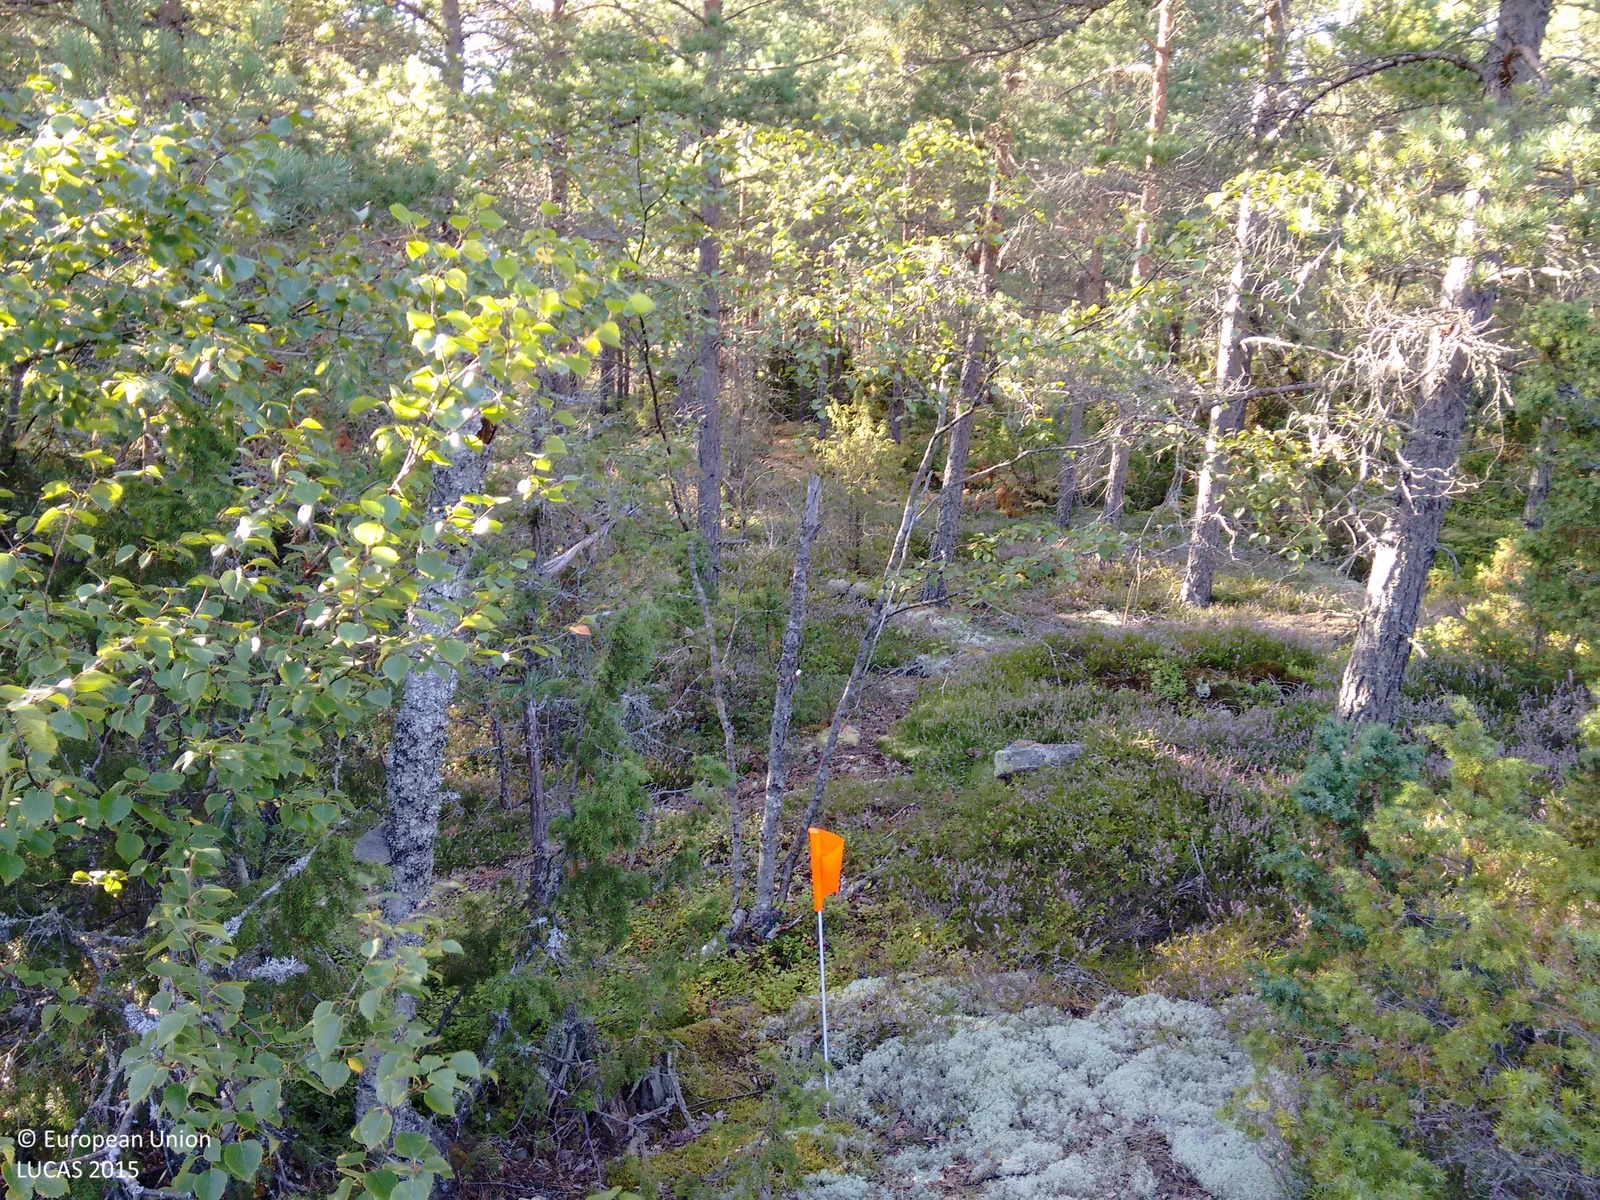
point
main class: Woodland
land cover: Pine dominated coniferous woodland
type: hemiboreal forest and nemoral coniferous forest and mixed broadleaved-coniferous forest
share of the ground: > 75 %
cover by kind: coniferous forest trees 70 %, broadleaved forest trees 15 %, lichens and mosses 10 %, unconsolidated bare surface 5 %
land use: Amenities, museums, leisure
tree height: > 5 m
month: August
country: FI
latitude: 60.1741
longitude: 19.9382
